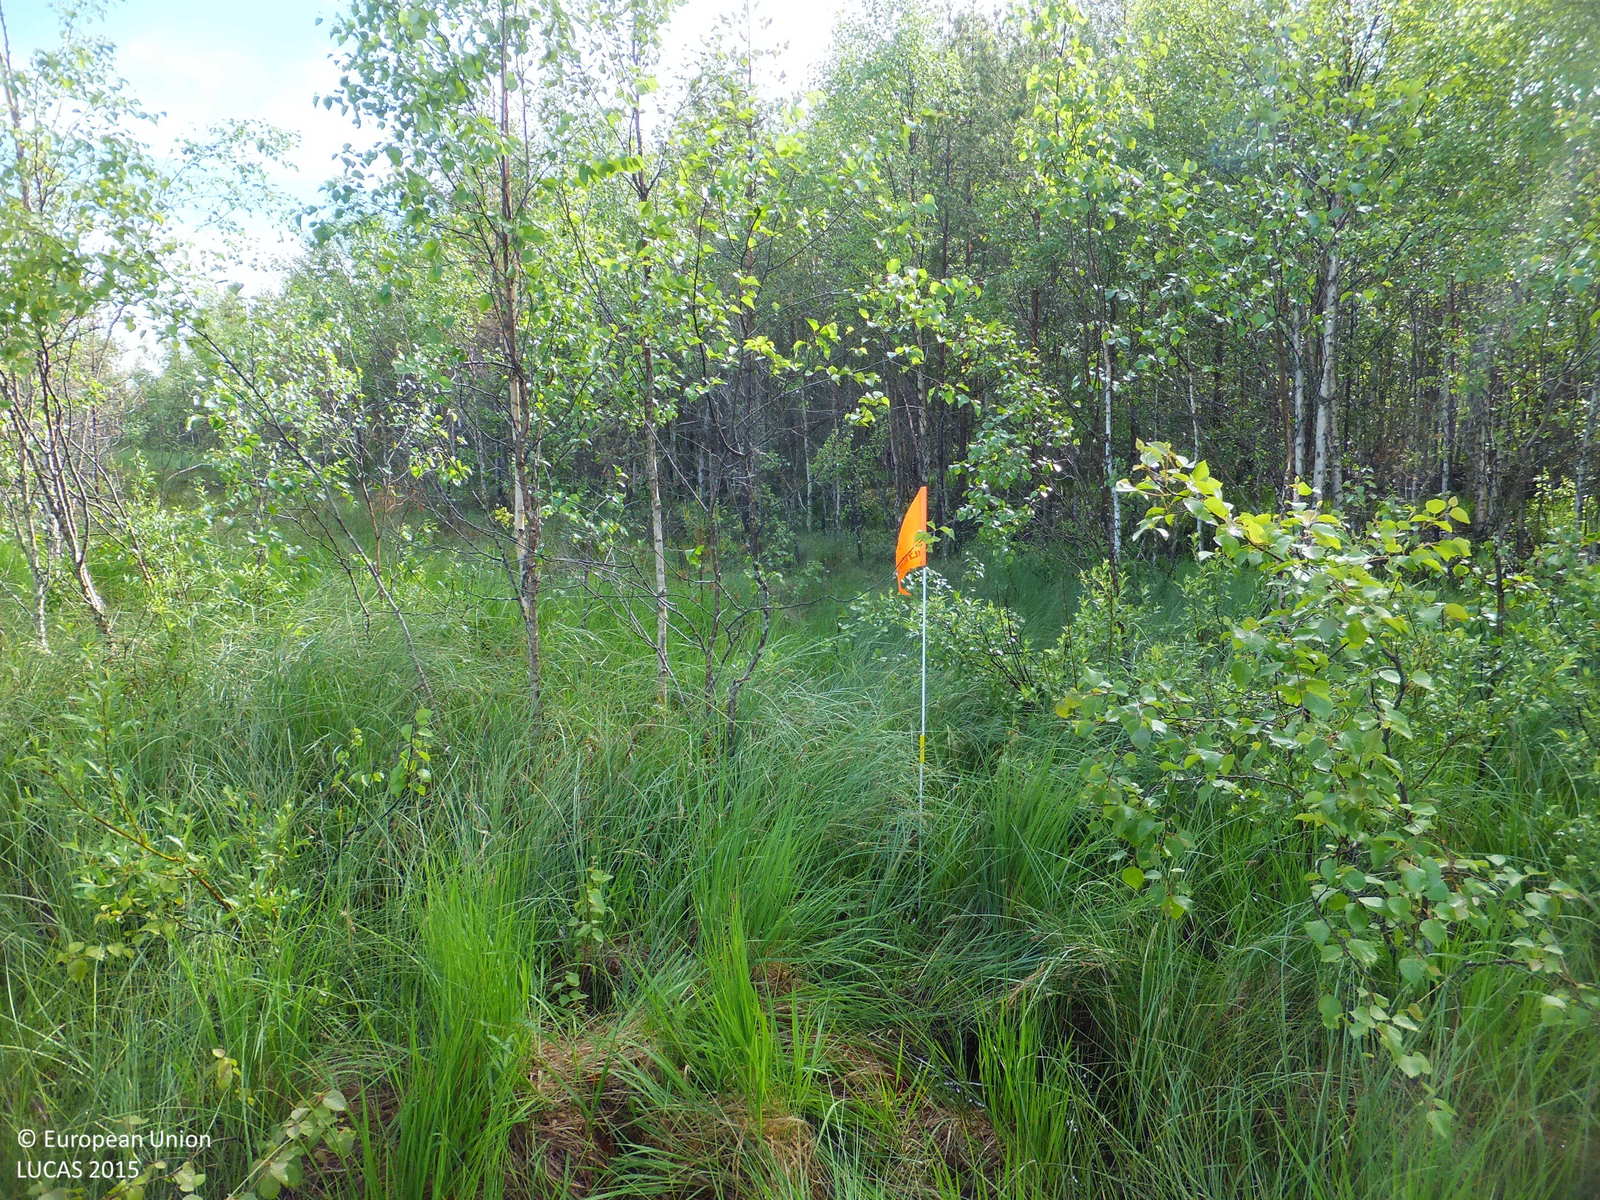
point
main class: Woodland
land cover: Broadleaved woodland
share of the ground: 25 - 50 %
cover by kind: broadleaved forest trees 30 %, herbaceous plants 30 %, shrubs 20 %, lichens and mosses 10 %
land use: Semi-natural and natural areas not in use
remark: Temporary flooded
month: June
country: FI
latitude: 63.4325
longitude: 24.6941
